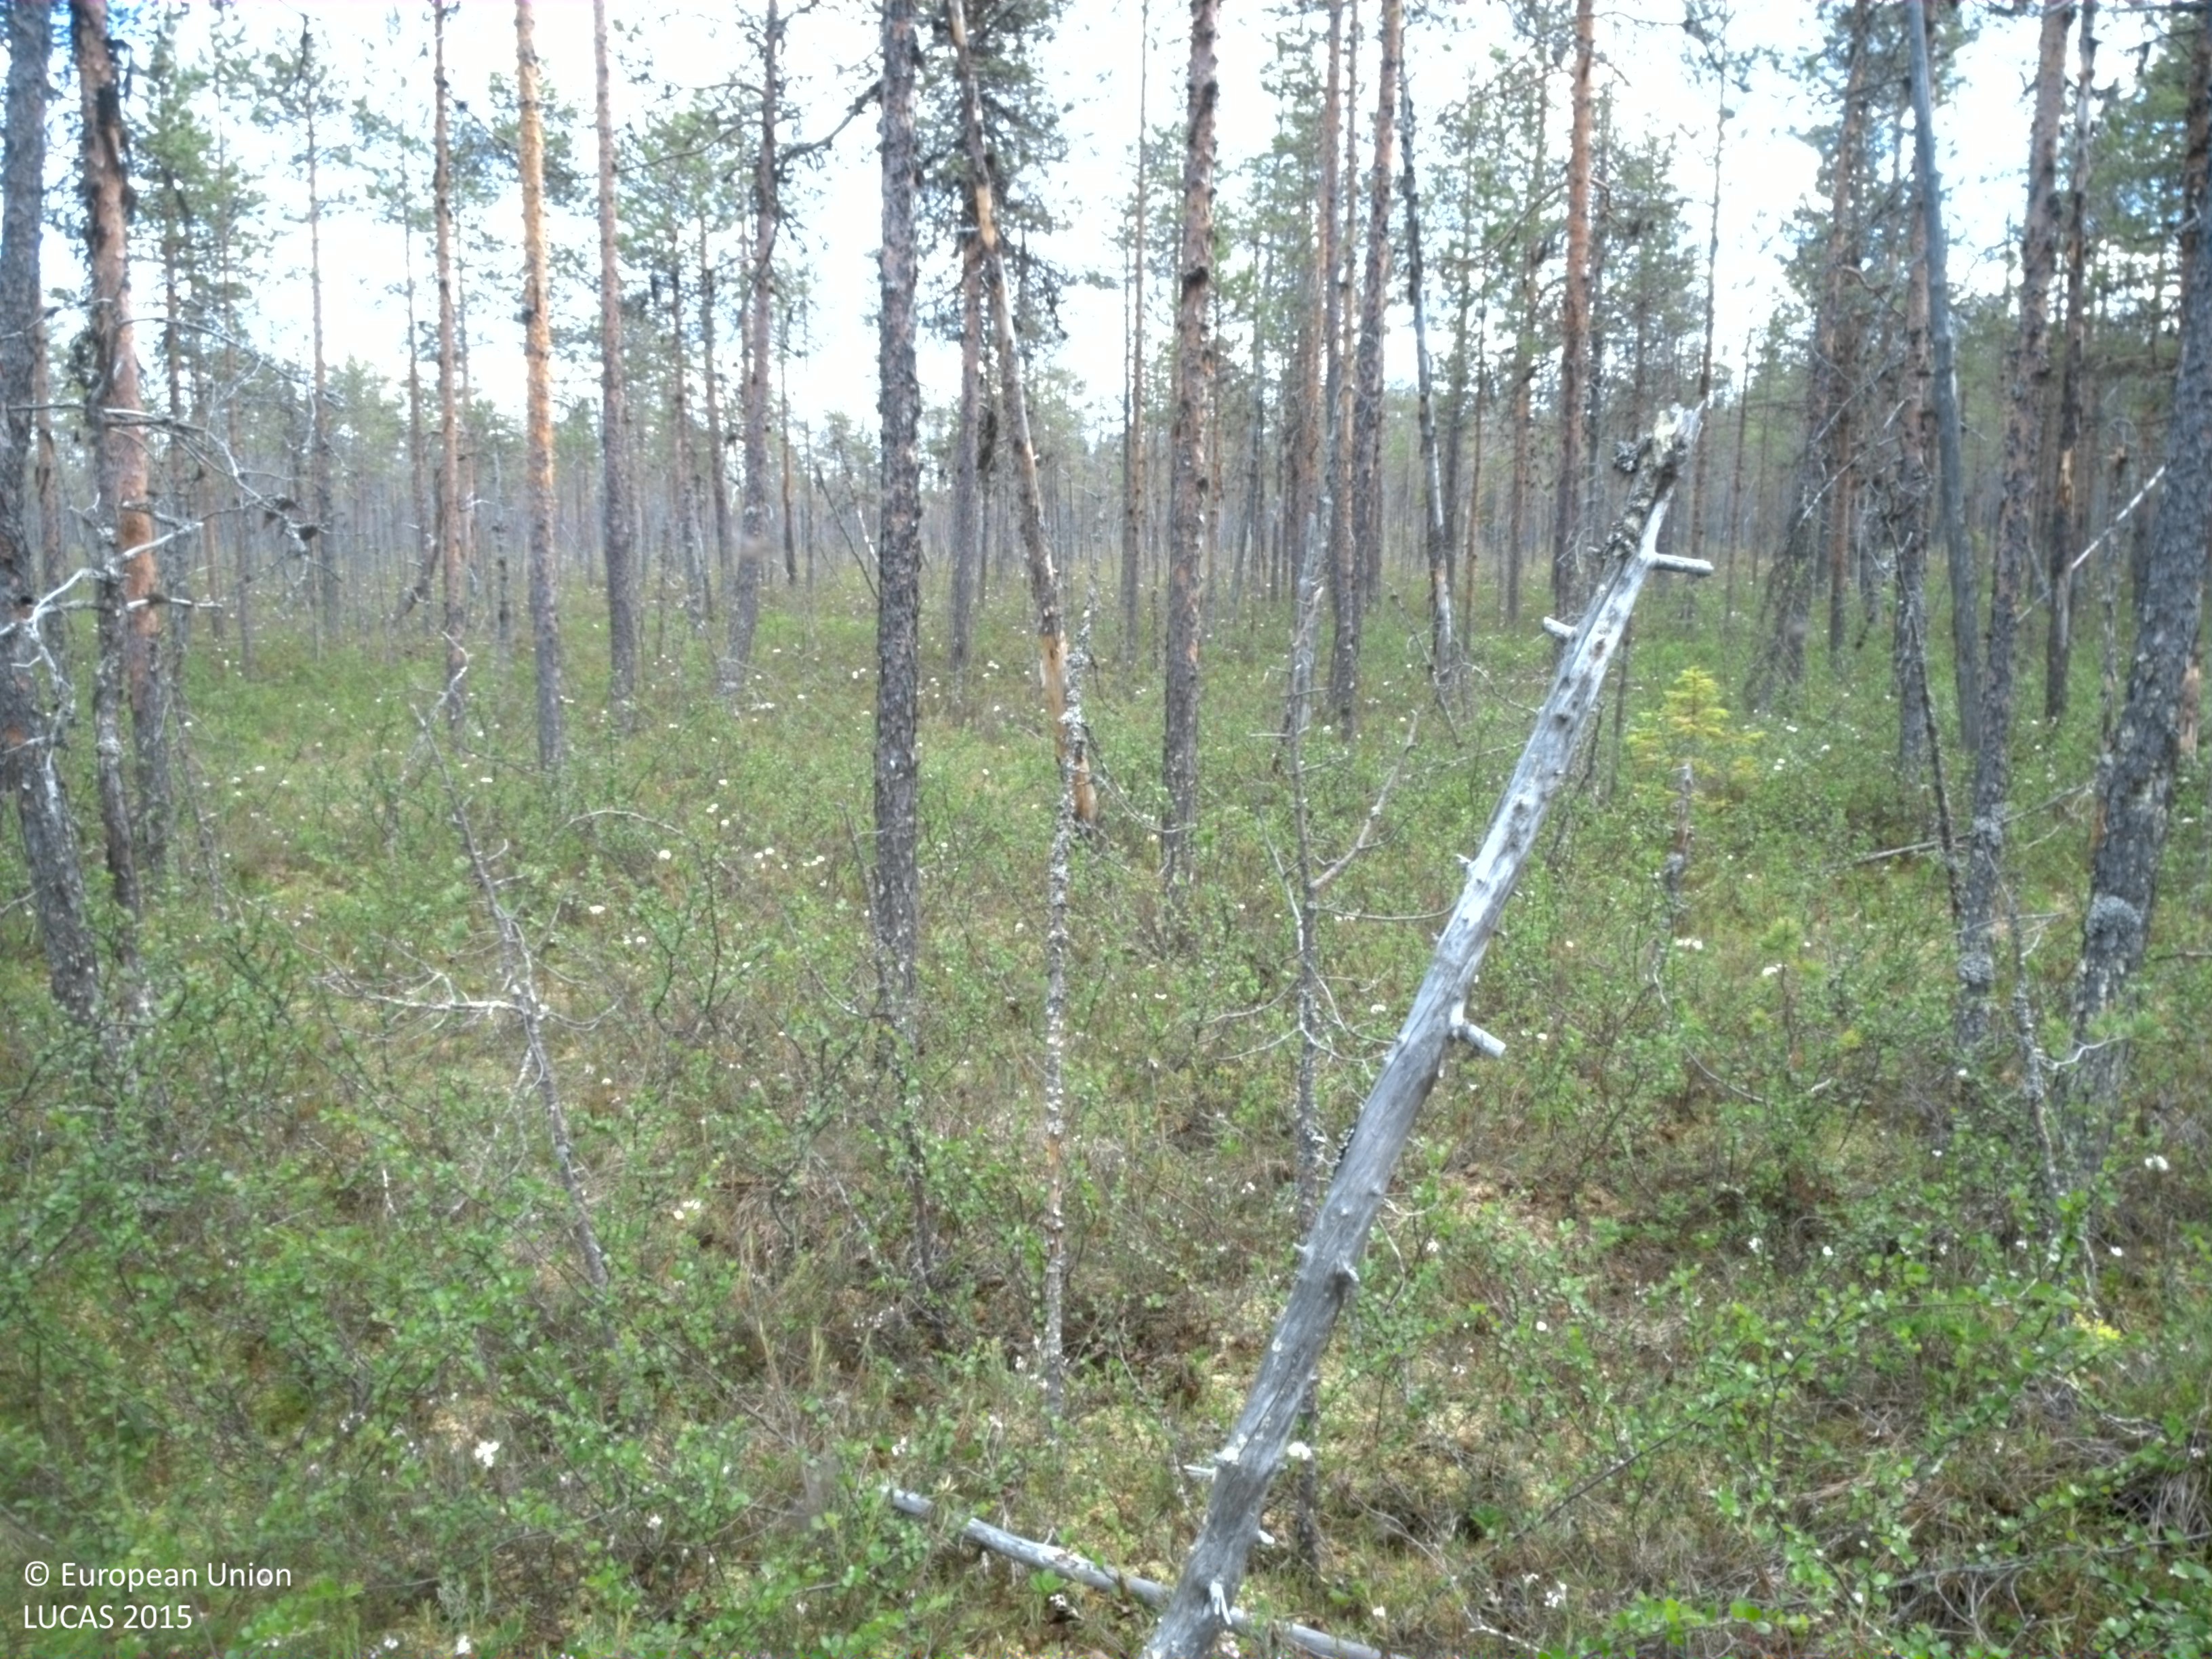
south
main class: Woodland
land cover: Pine dominated coniferous woodland
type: mire and swamp forests
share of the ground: 25 - 50 %
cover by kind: shrubs 65 %, coniferous forest trees 30 %, lichens and mosses 5 %
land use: Semi-natural and natural areas not in use
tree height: > 5 m
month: June
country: SE
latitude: 66.4377
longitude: 22.4589
